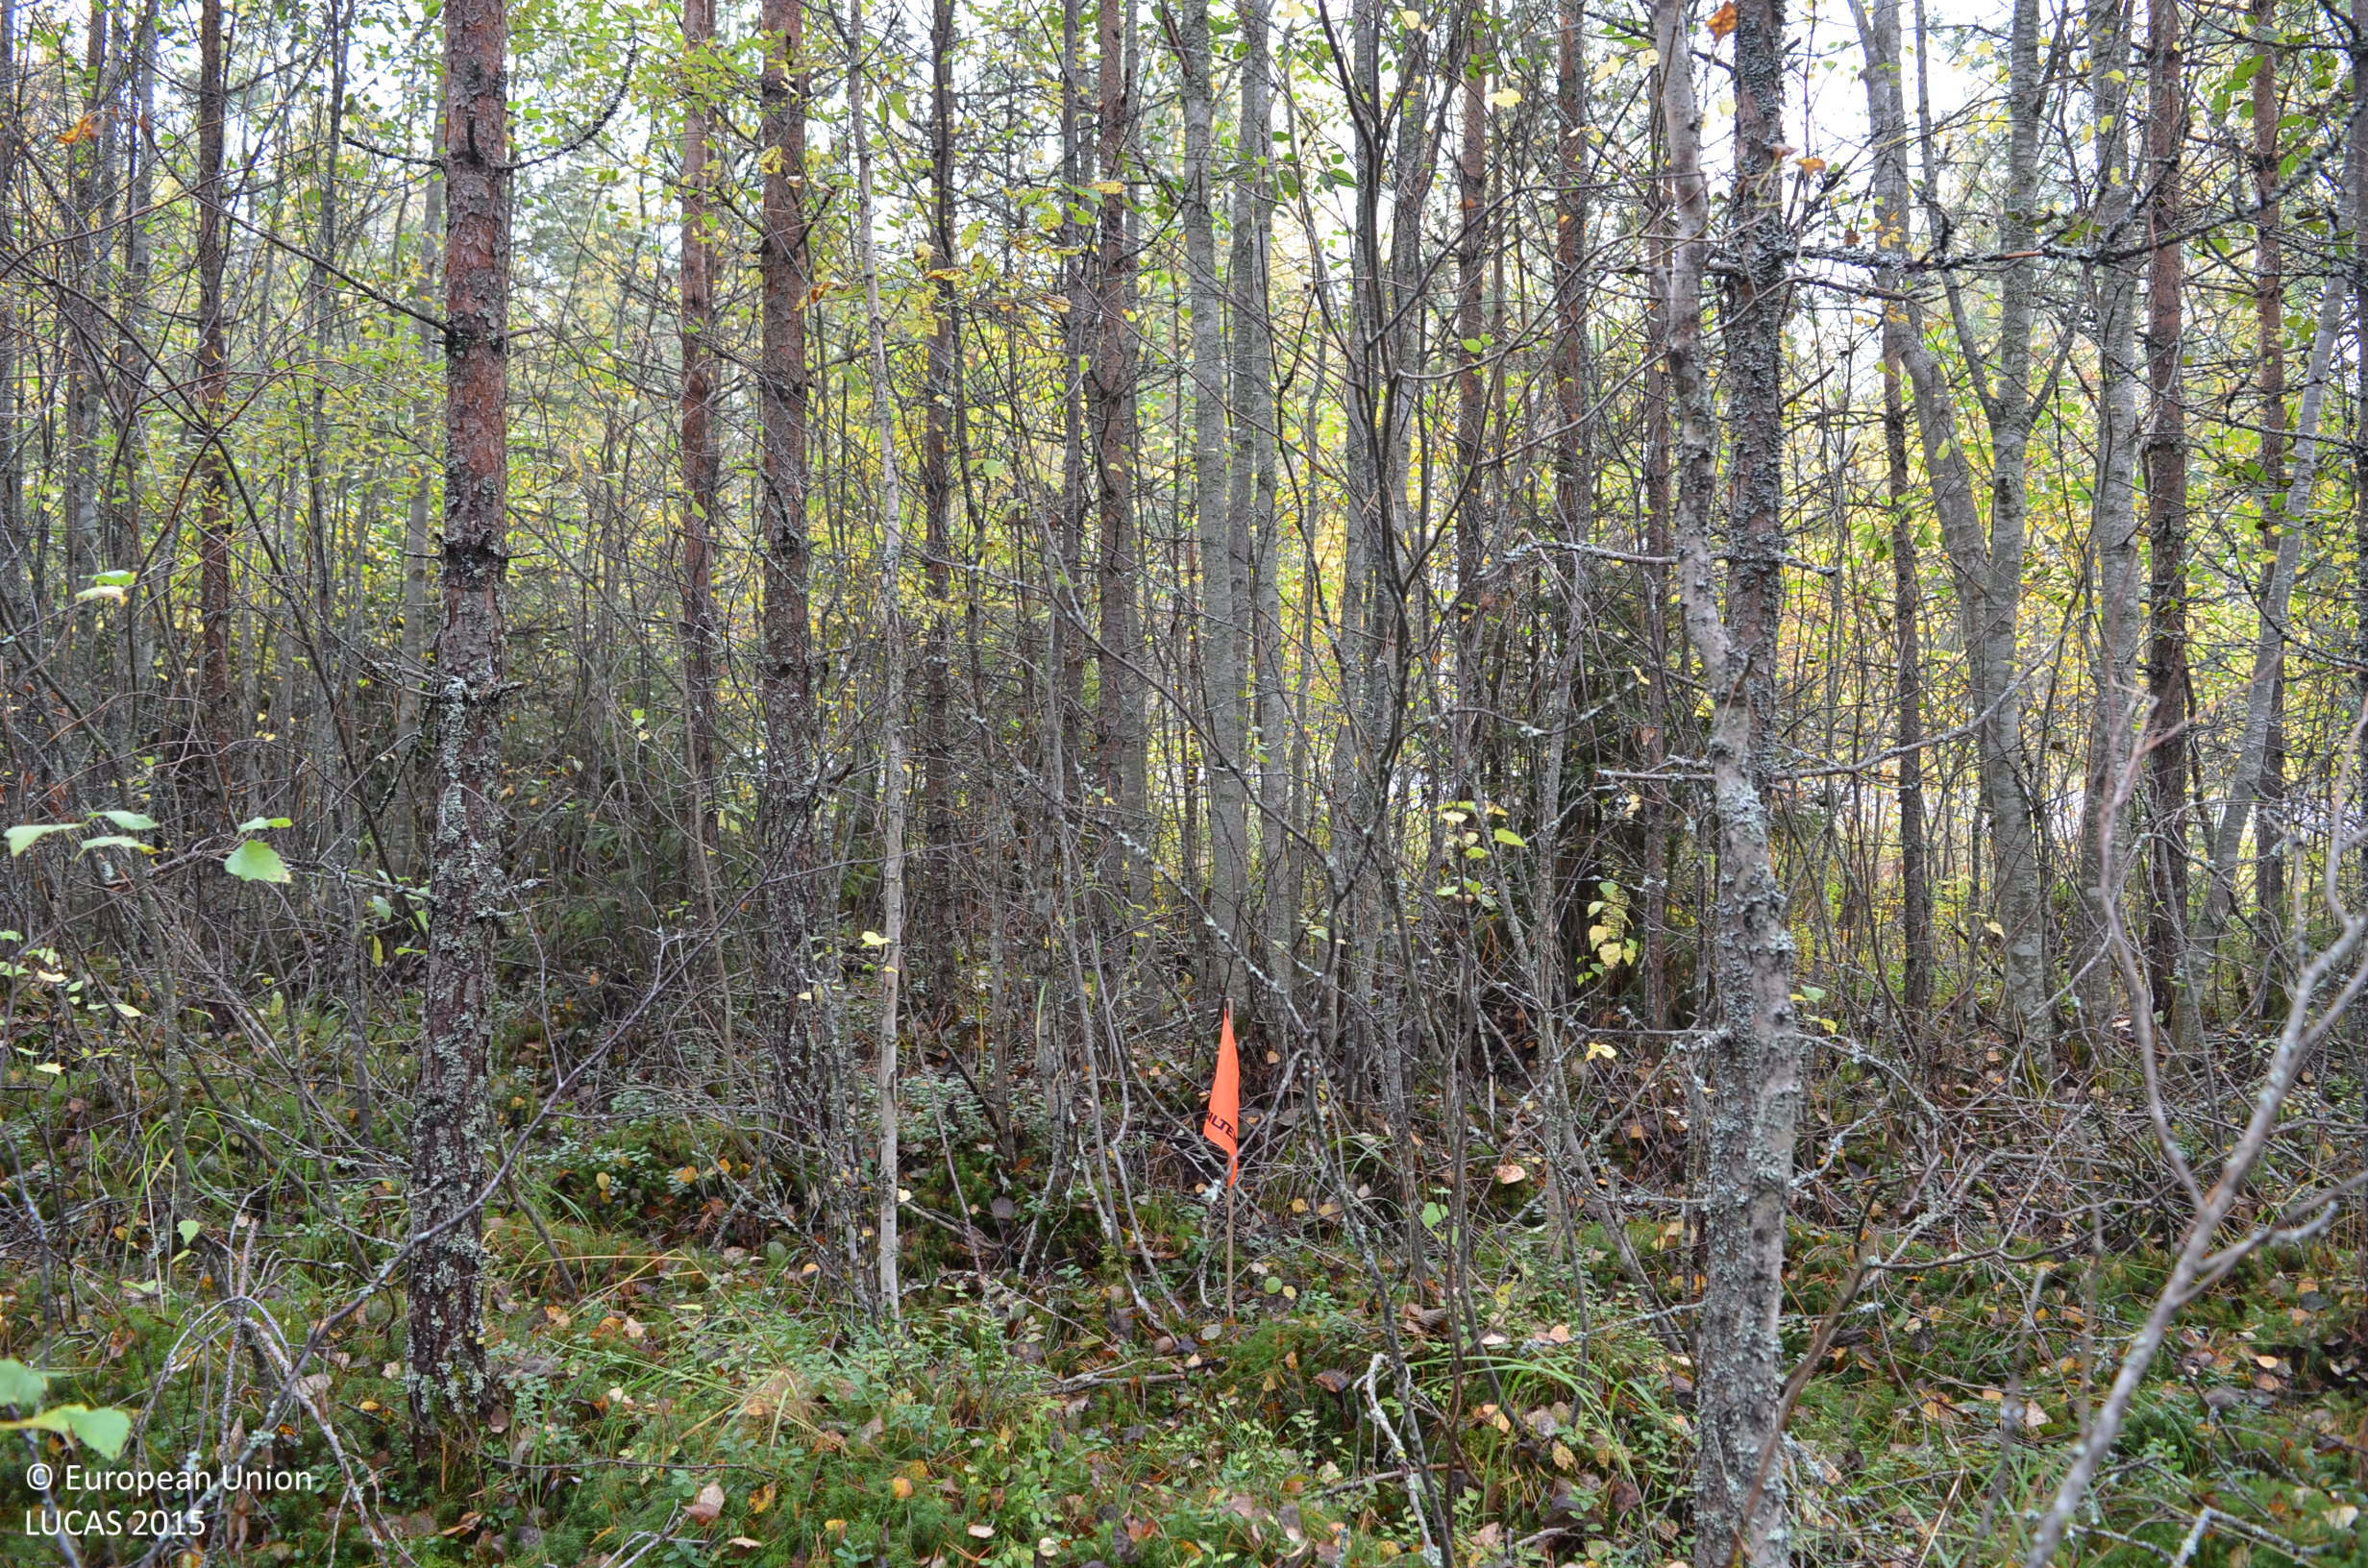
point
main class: Woodland
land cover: Pine dominated mixed woodland
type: boreal forest
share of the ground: > 75 %
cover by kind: broadleaved forest trees 50 %, coniferous forest trees 40 %, shrubs 5 %, lichens and mosses 5 %
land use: Forestry
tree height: > 5 m
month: September
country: FI
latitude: 62.5365
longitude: 23.6595
